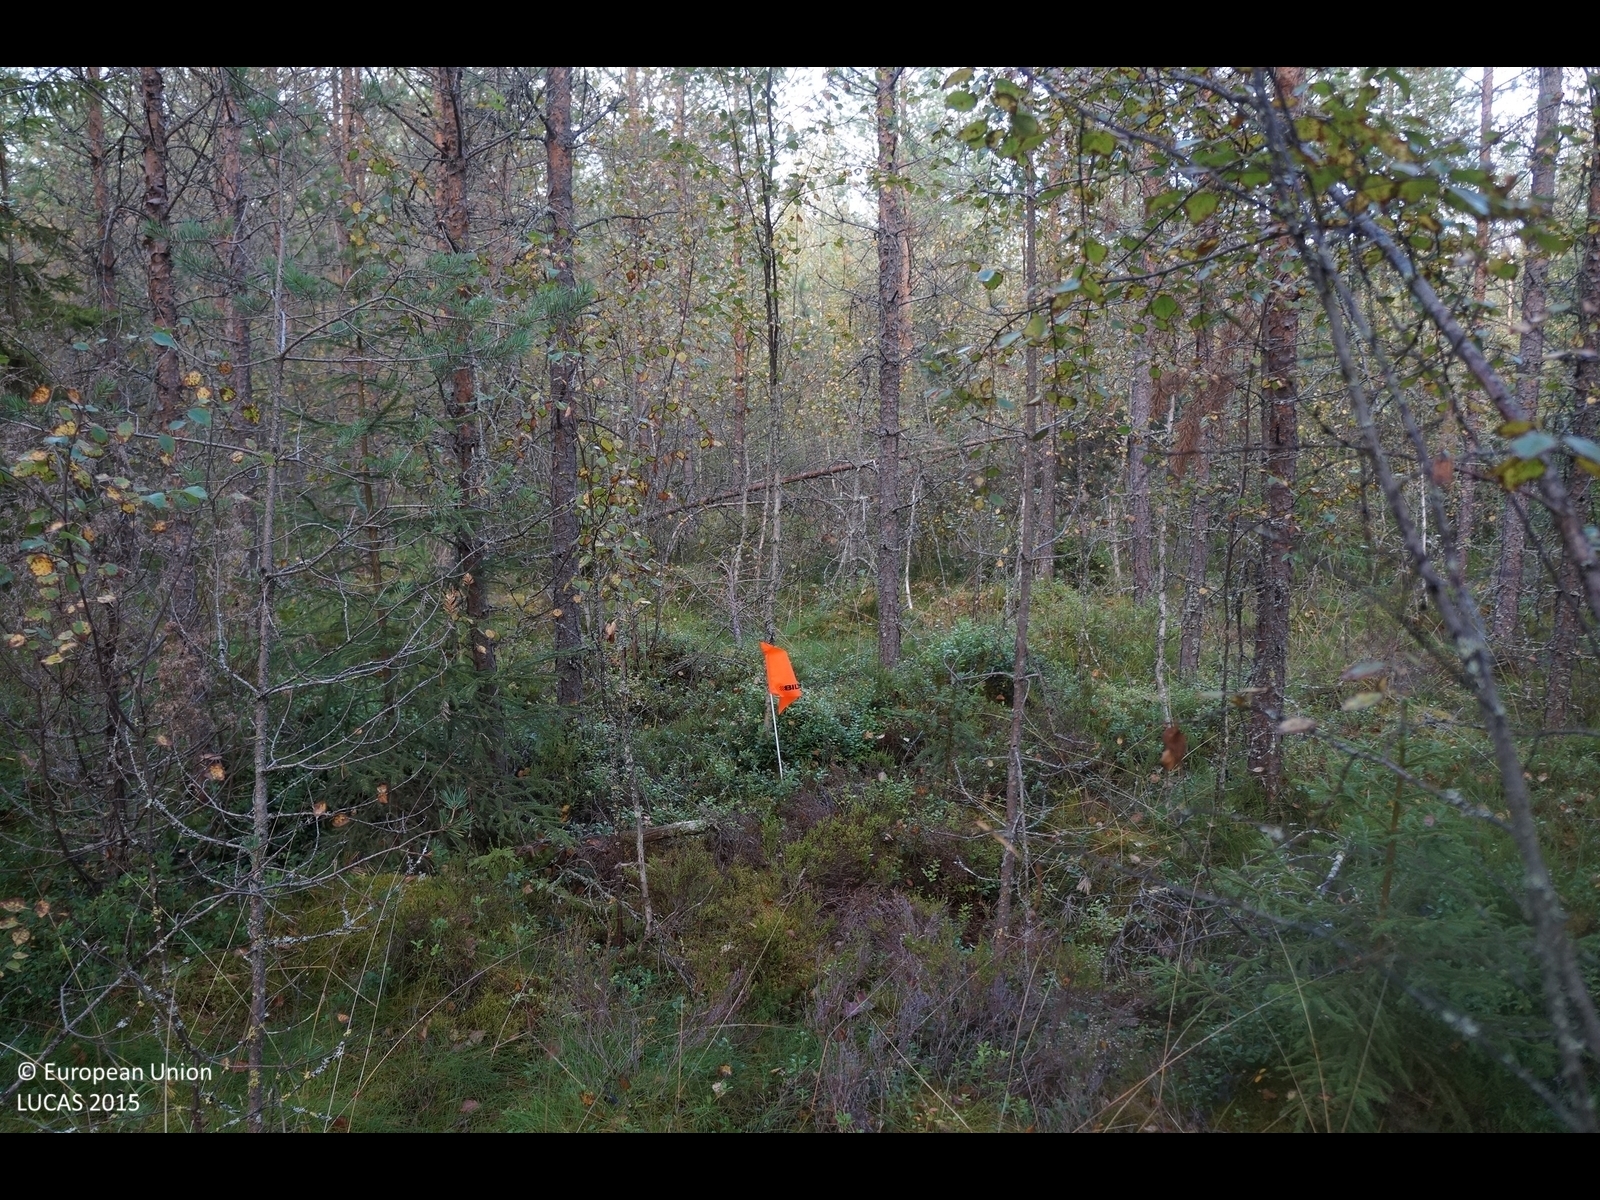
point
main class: Woodland
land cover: Pine dominated coniferous woodland
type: boreal forest
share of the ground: 50 - 75 %
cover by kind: coniferous forest trees 70 %, shrubs 20 %, herbaceous plants 5 %, lichens and mosses 5 %
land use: Forestry
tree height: > 5 m
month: September
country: FI
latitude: 63.8786
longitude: 24.2606
